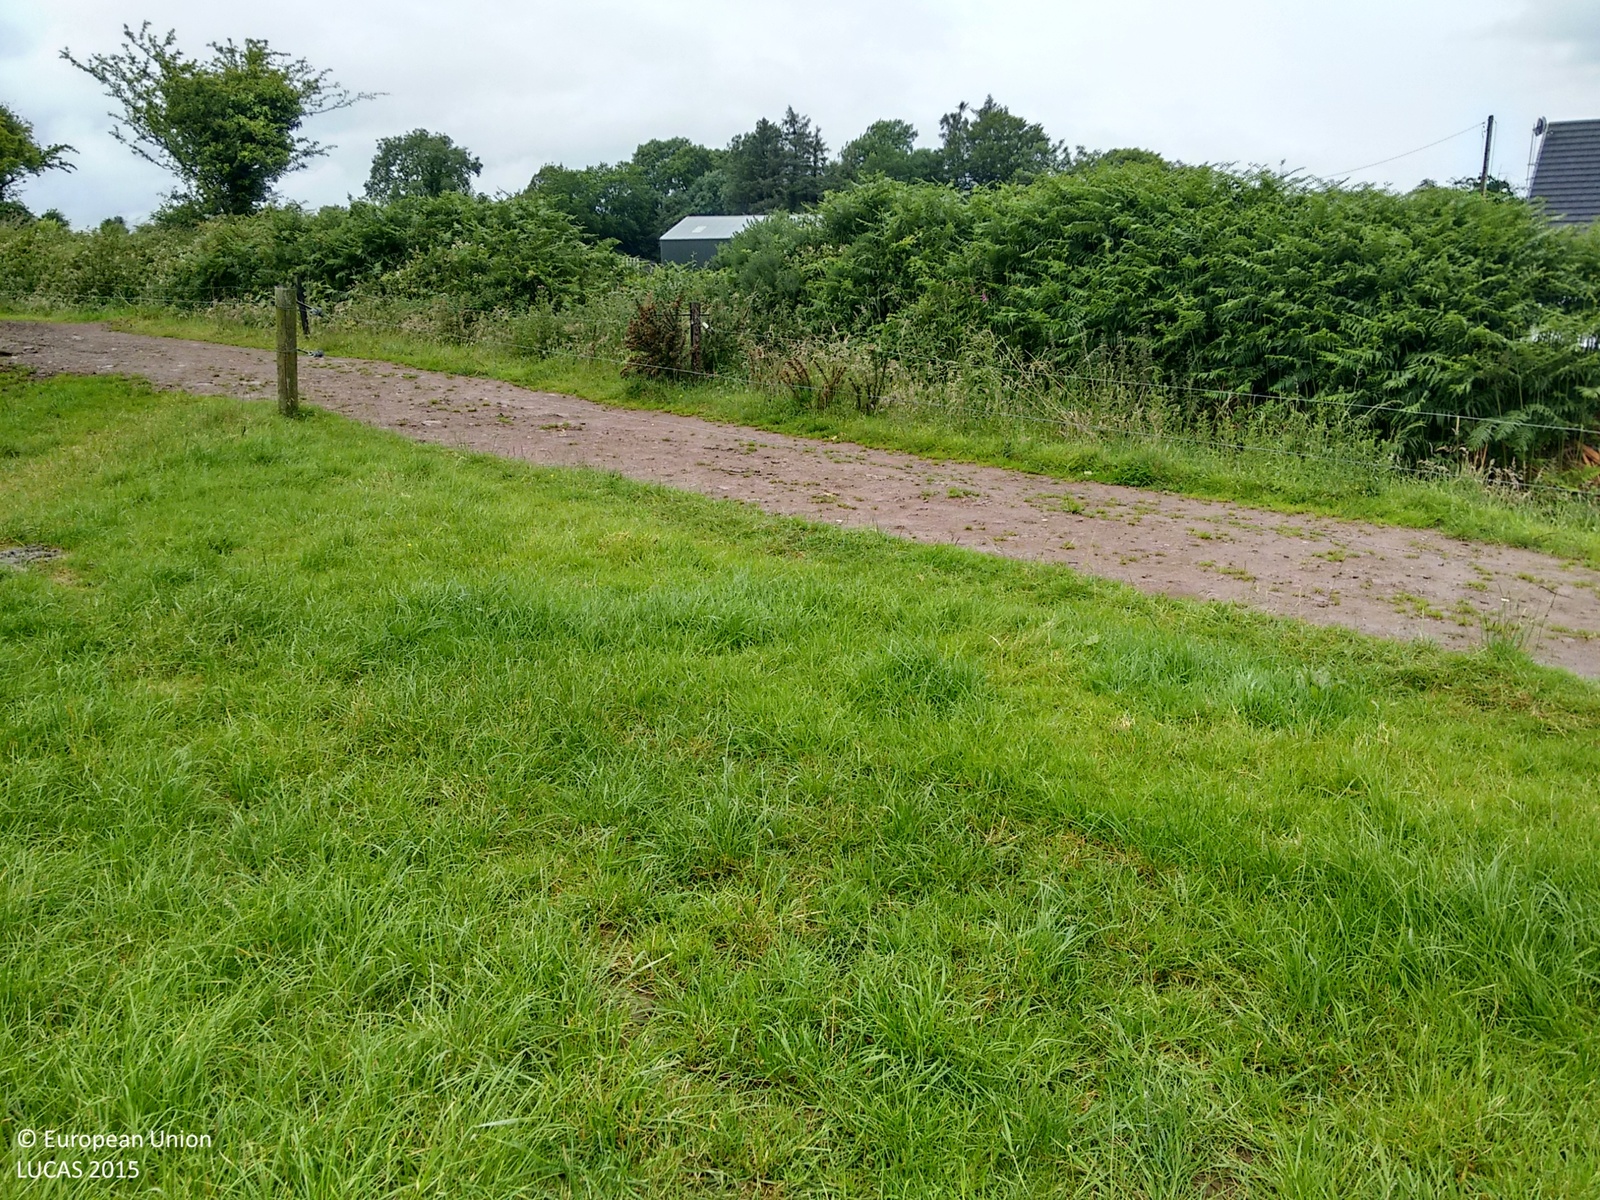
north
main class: Grassland
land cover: Grassland without tree/shrub cover
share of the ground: > 75 %
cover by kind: herbaceous plants 90 %, shrubs 5 %, unconsolidated bare surface 5 %
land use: Agriculture (excluding fallow land and kitchen gardens)
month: July
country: IE
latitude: 52.1910
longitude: -8.1902
